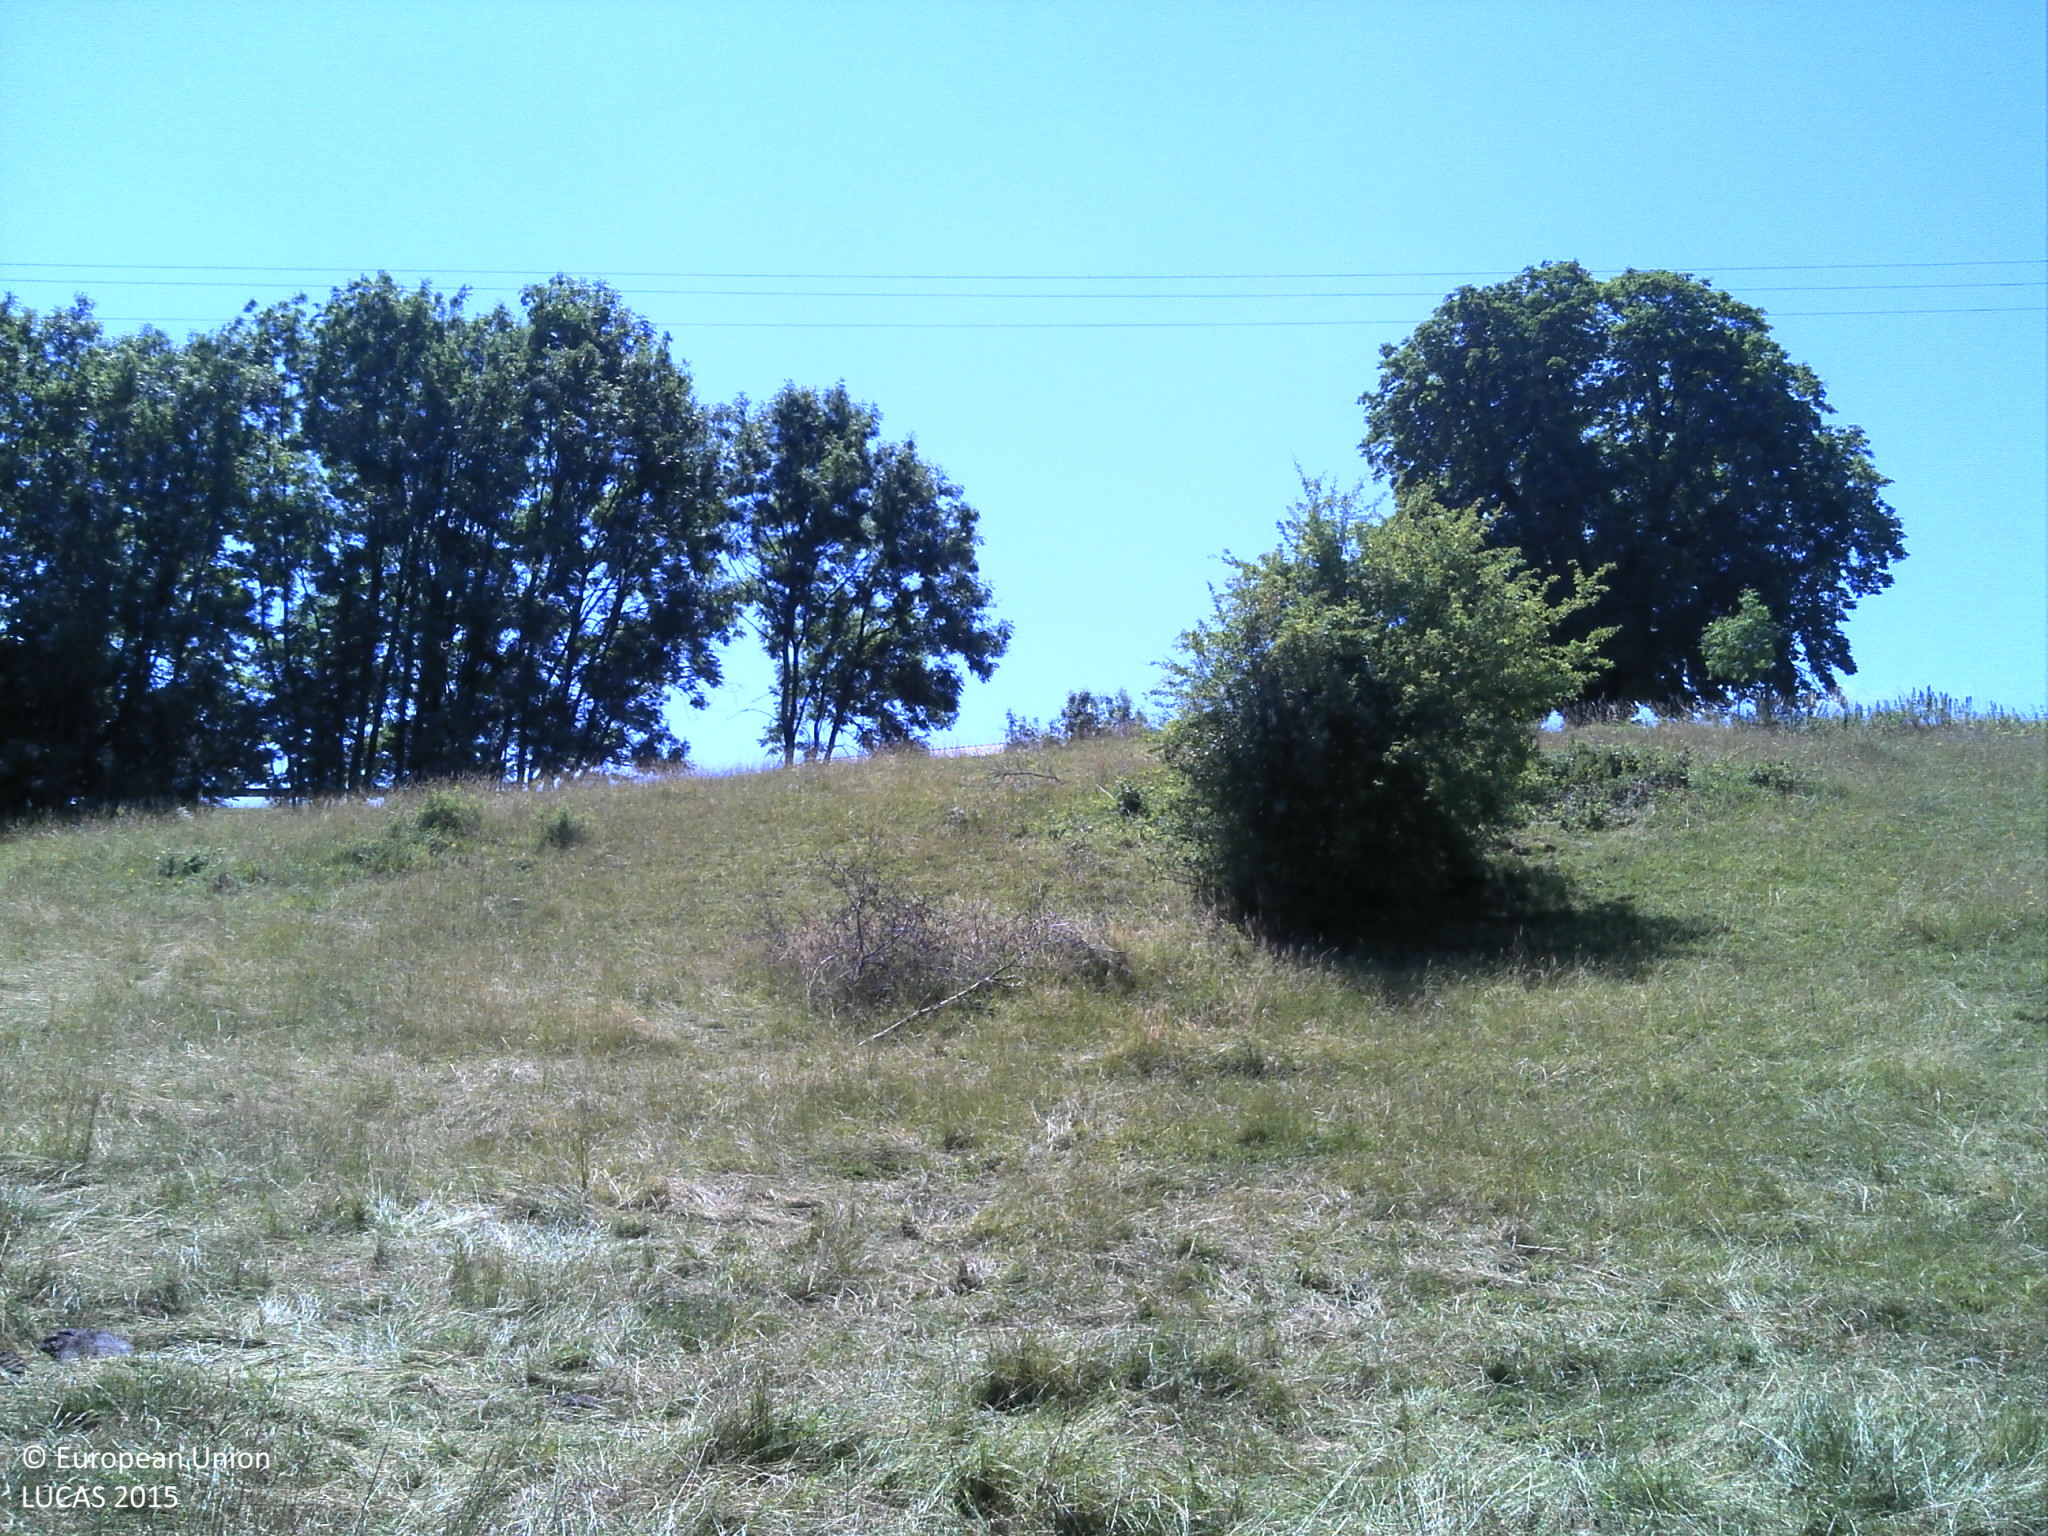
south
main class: Grassland
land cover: Grassland without tree/shrub cover
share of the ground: > 75 %
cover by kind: herbaceous plants 100 %
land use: Agriculture (excluding fallow land and kitchen gardens)
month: July
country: FR
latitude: 49.5744
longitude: 4.7002
